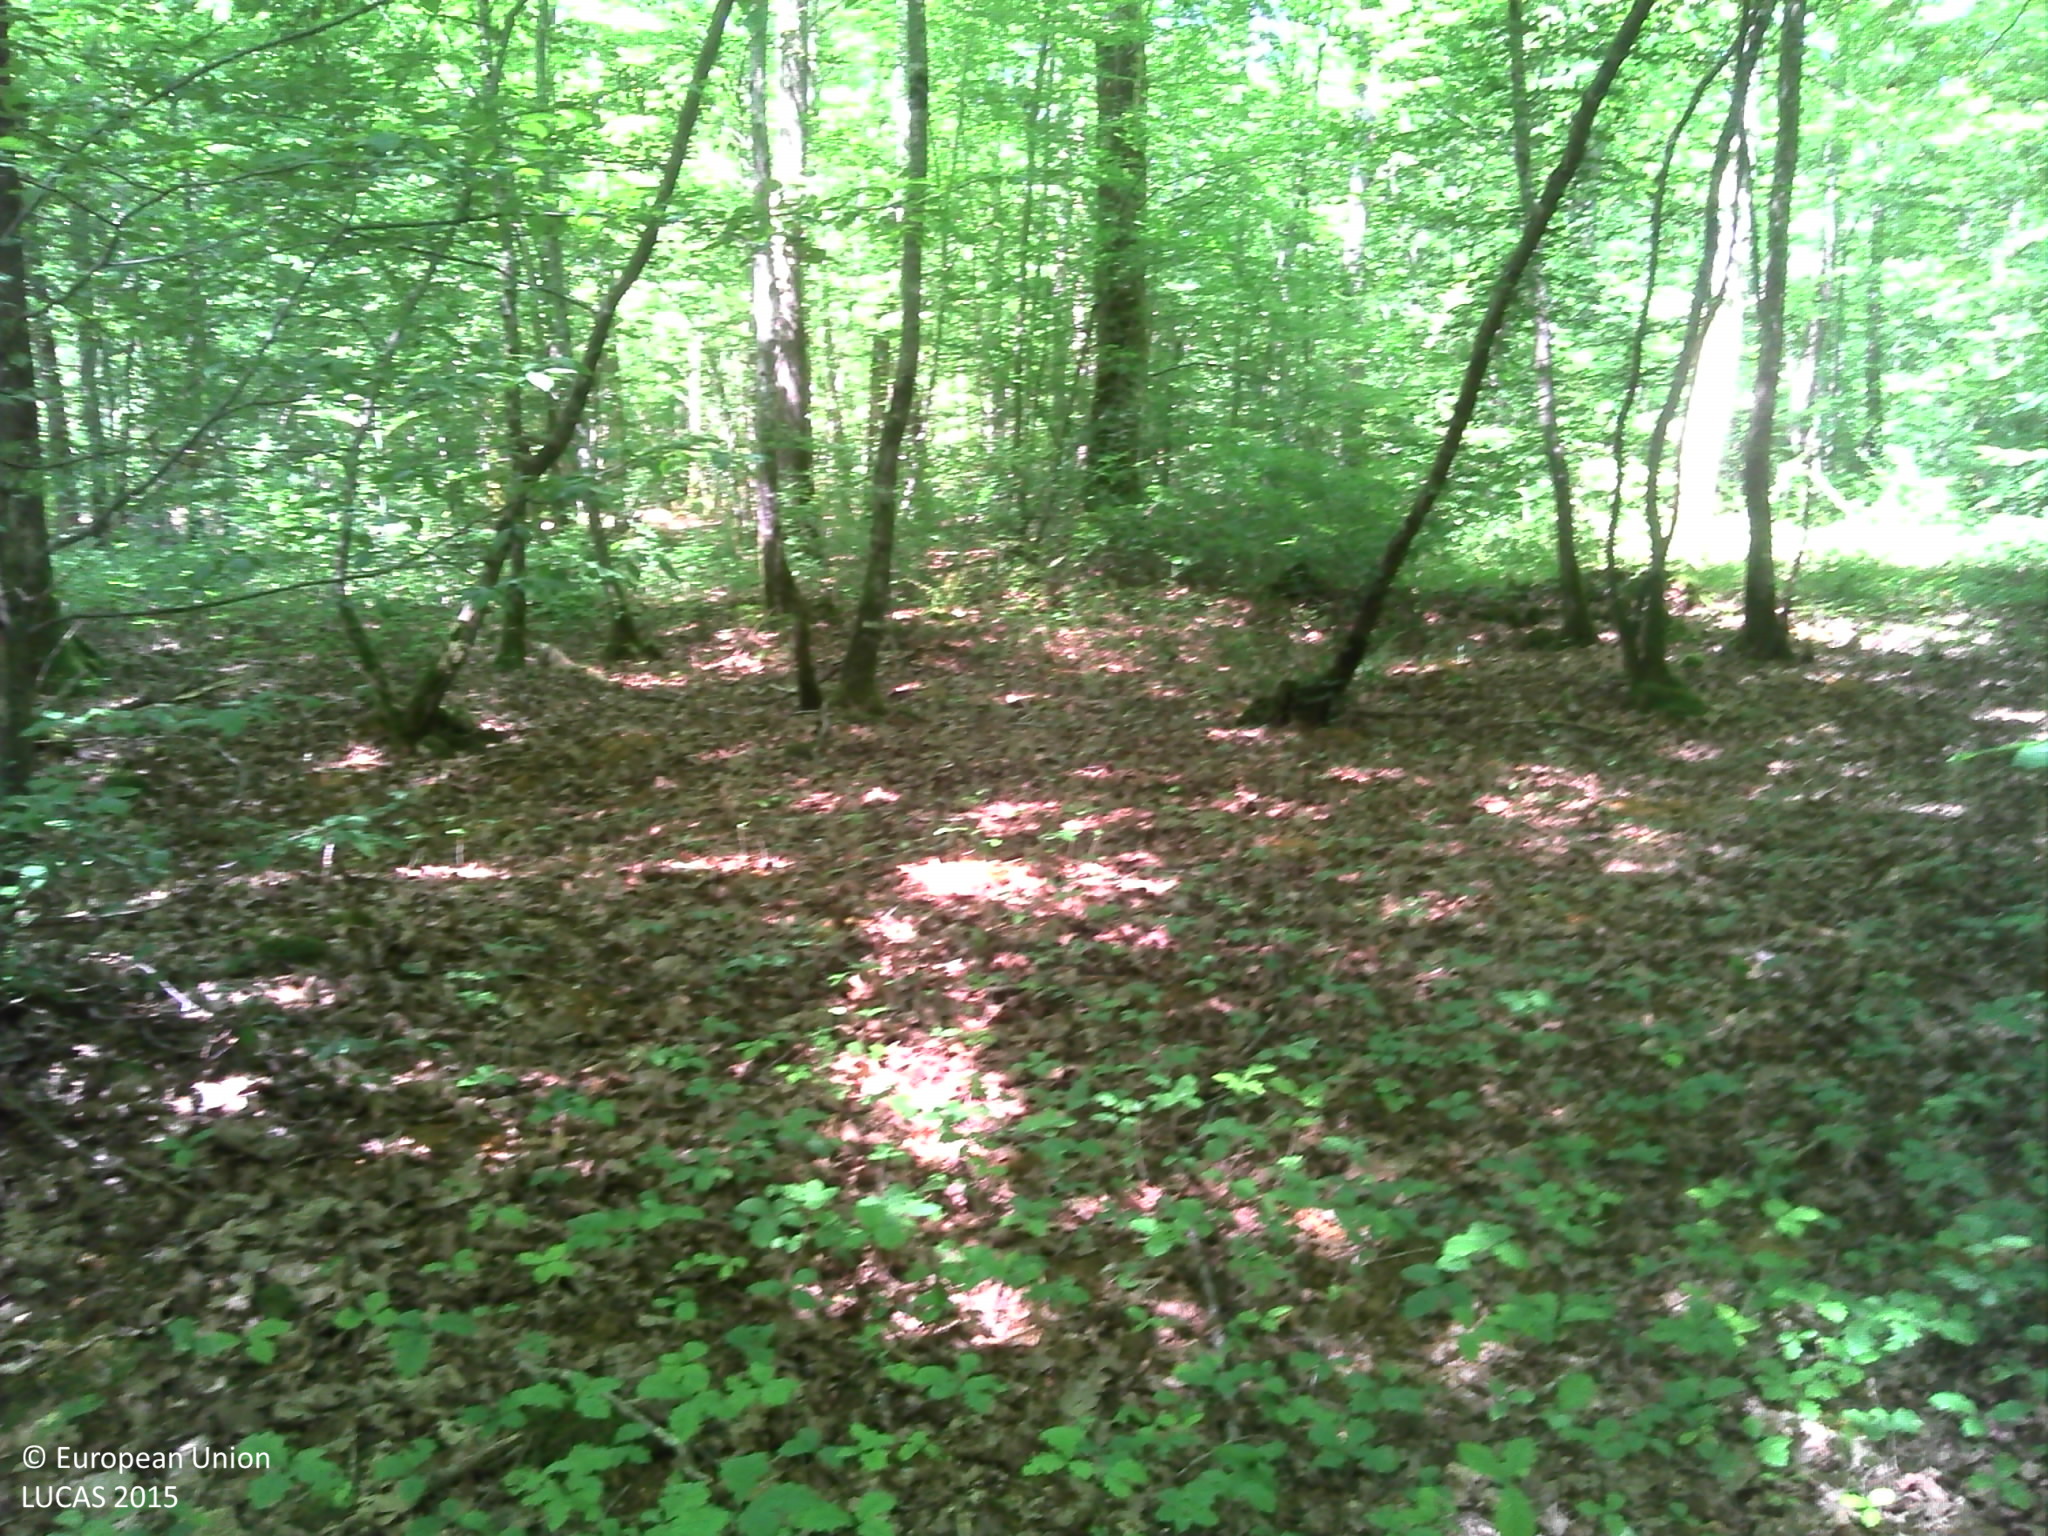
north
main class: Woodland
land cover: Broadleaved woodland
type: mesophytic deciduous forest
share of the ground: > 75 %
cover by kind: broadleaved forest trees 90 %, herbaceous plants 5 %, lichens and mosses 5 %
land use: Forestry
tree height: > 5 m
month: June
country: FR
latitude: 47.4772
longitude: 3.5874
